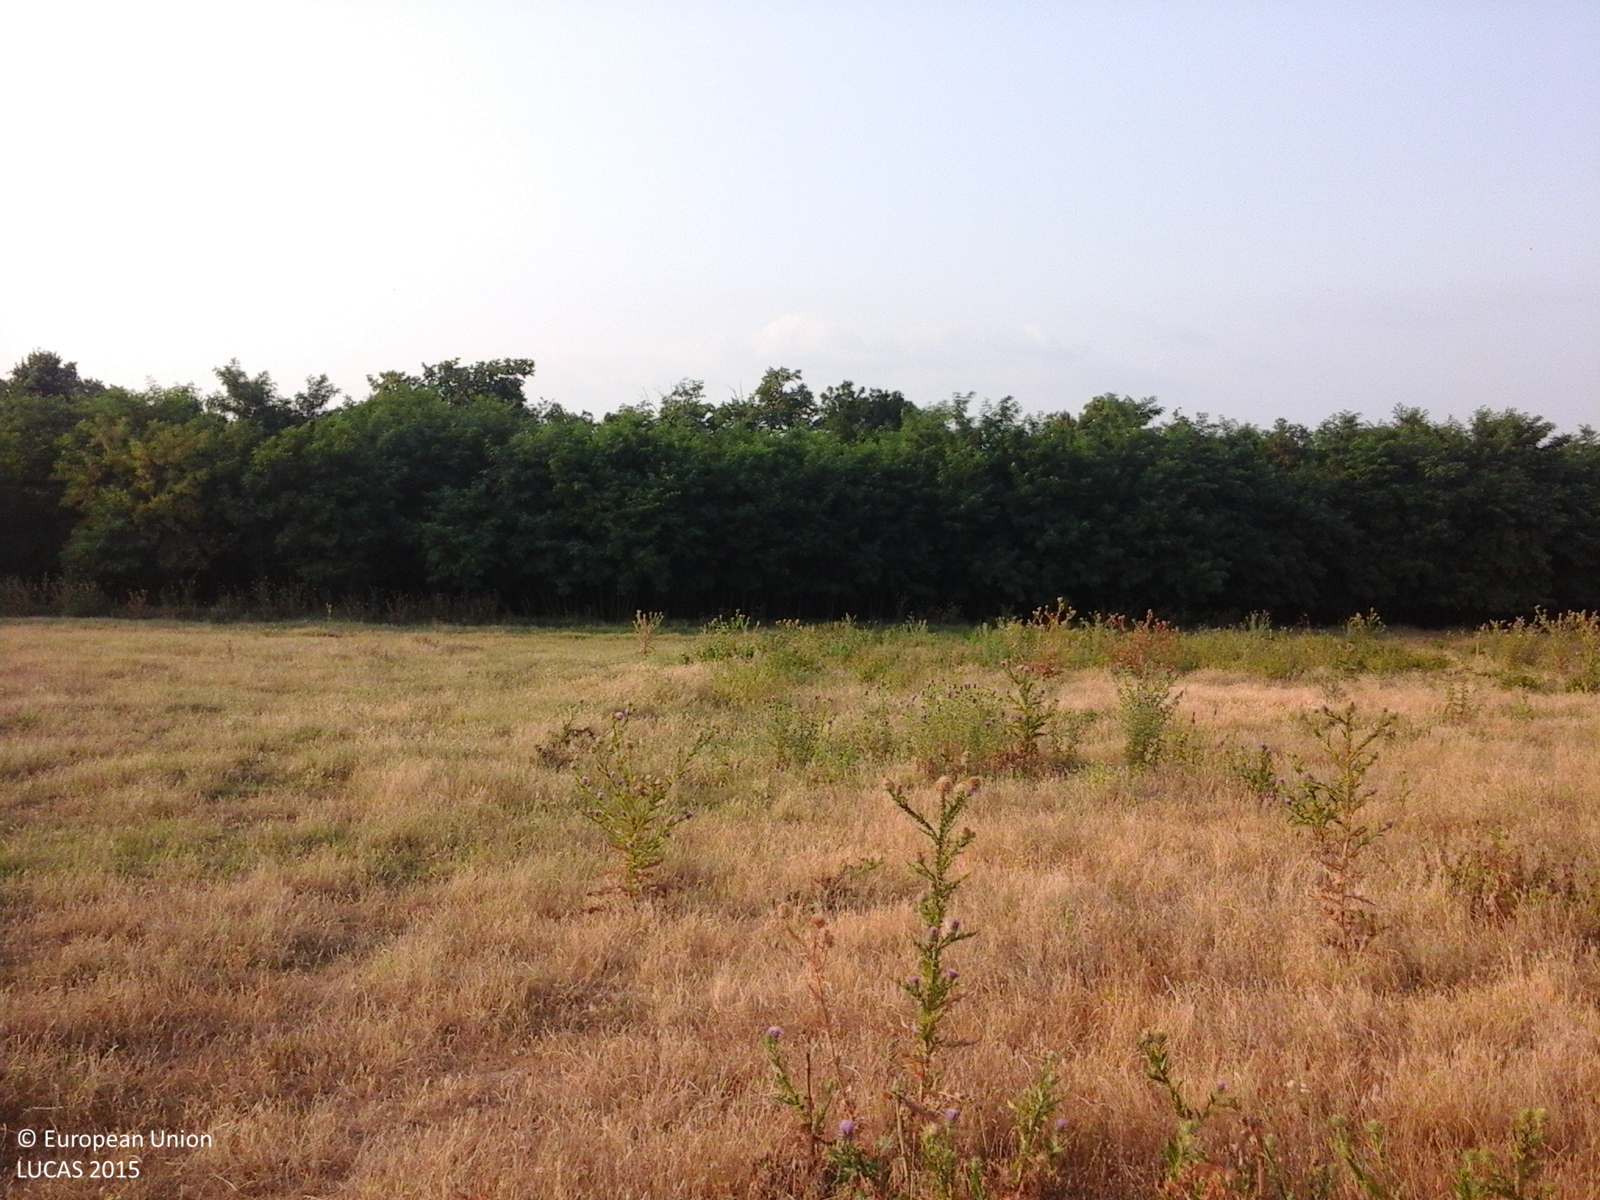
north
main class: Grassland
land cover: Grassland without tree/shrub cover
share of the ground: > 75 %
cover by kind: herbaceous plants 100 %
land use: Agriculture (excluding fallow land and kitchen gardens)
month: July
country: RO
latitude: 44.9075
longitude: 28.3748
